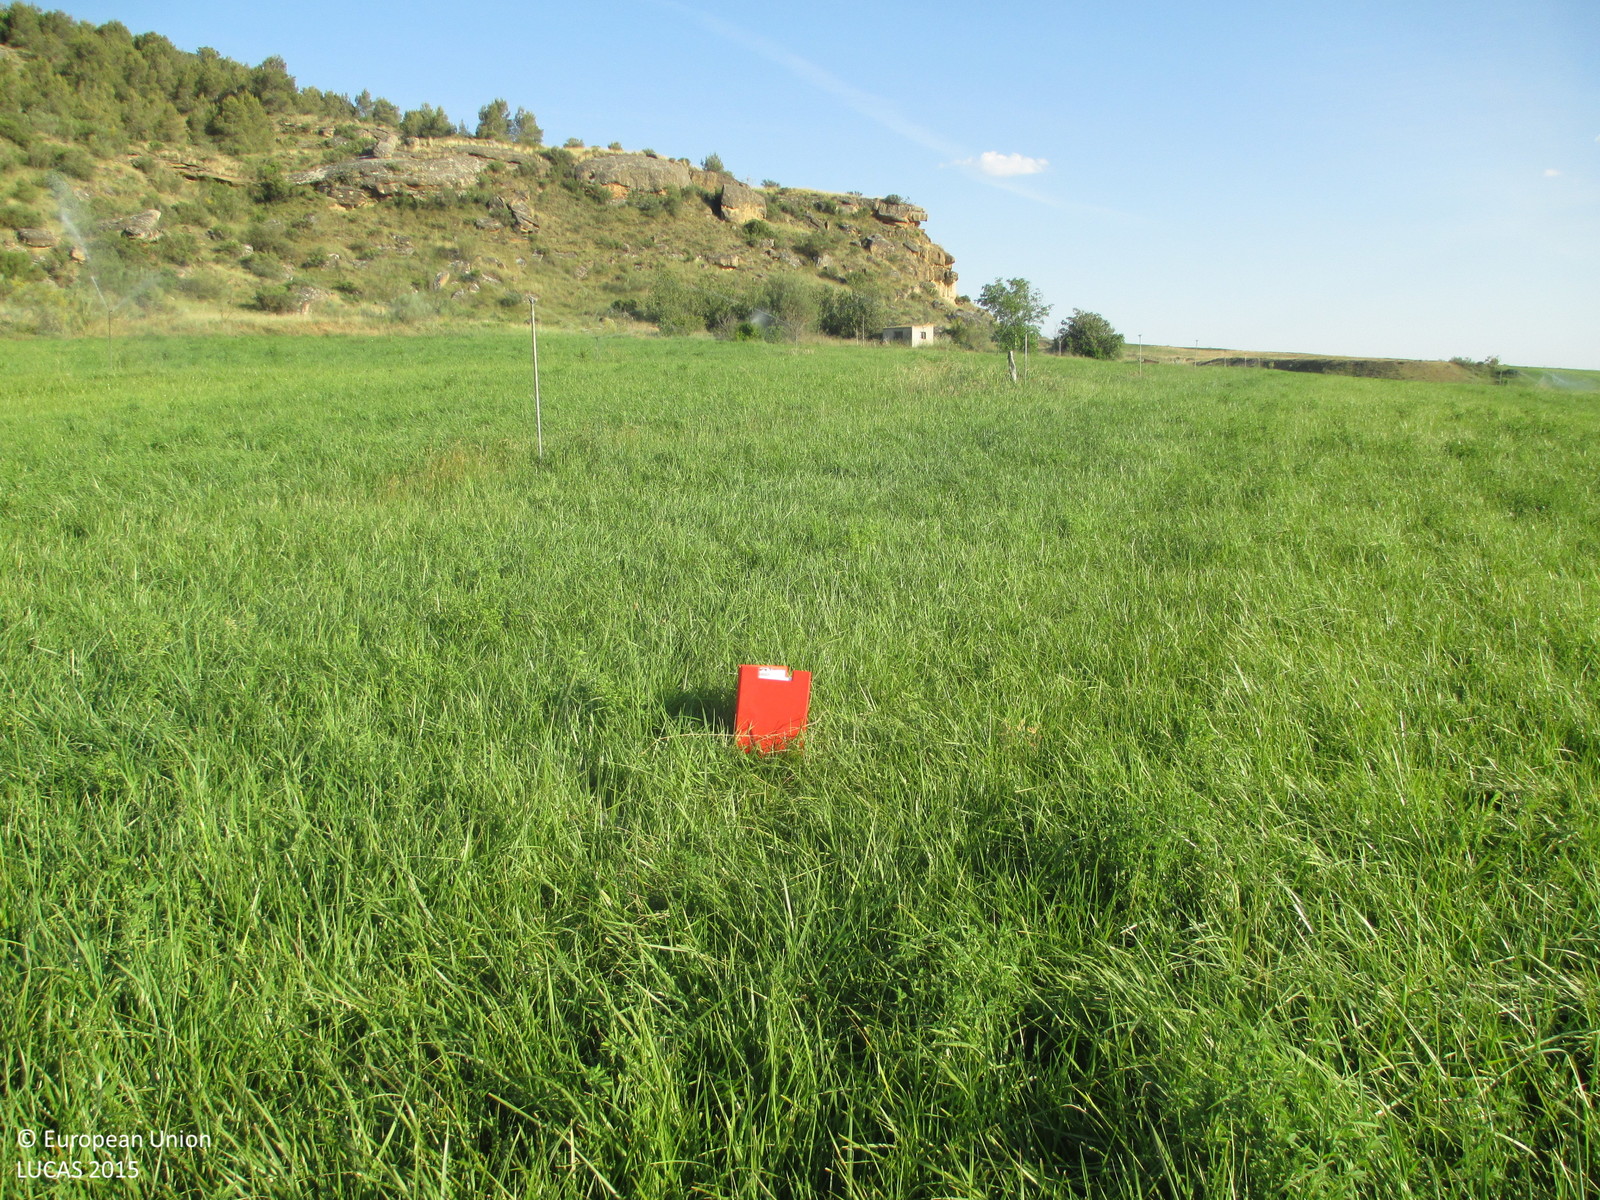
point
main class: Cropland
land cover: Other leguminous and mixtures for fodder
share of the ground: > 75 %
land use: Agriculture (excluding fallow land and kitchen gardens)
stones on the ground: 25 - 50 %
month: May
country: ES
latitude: 41.8341
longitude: -0.1452
